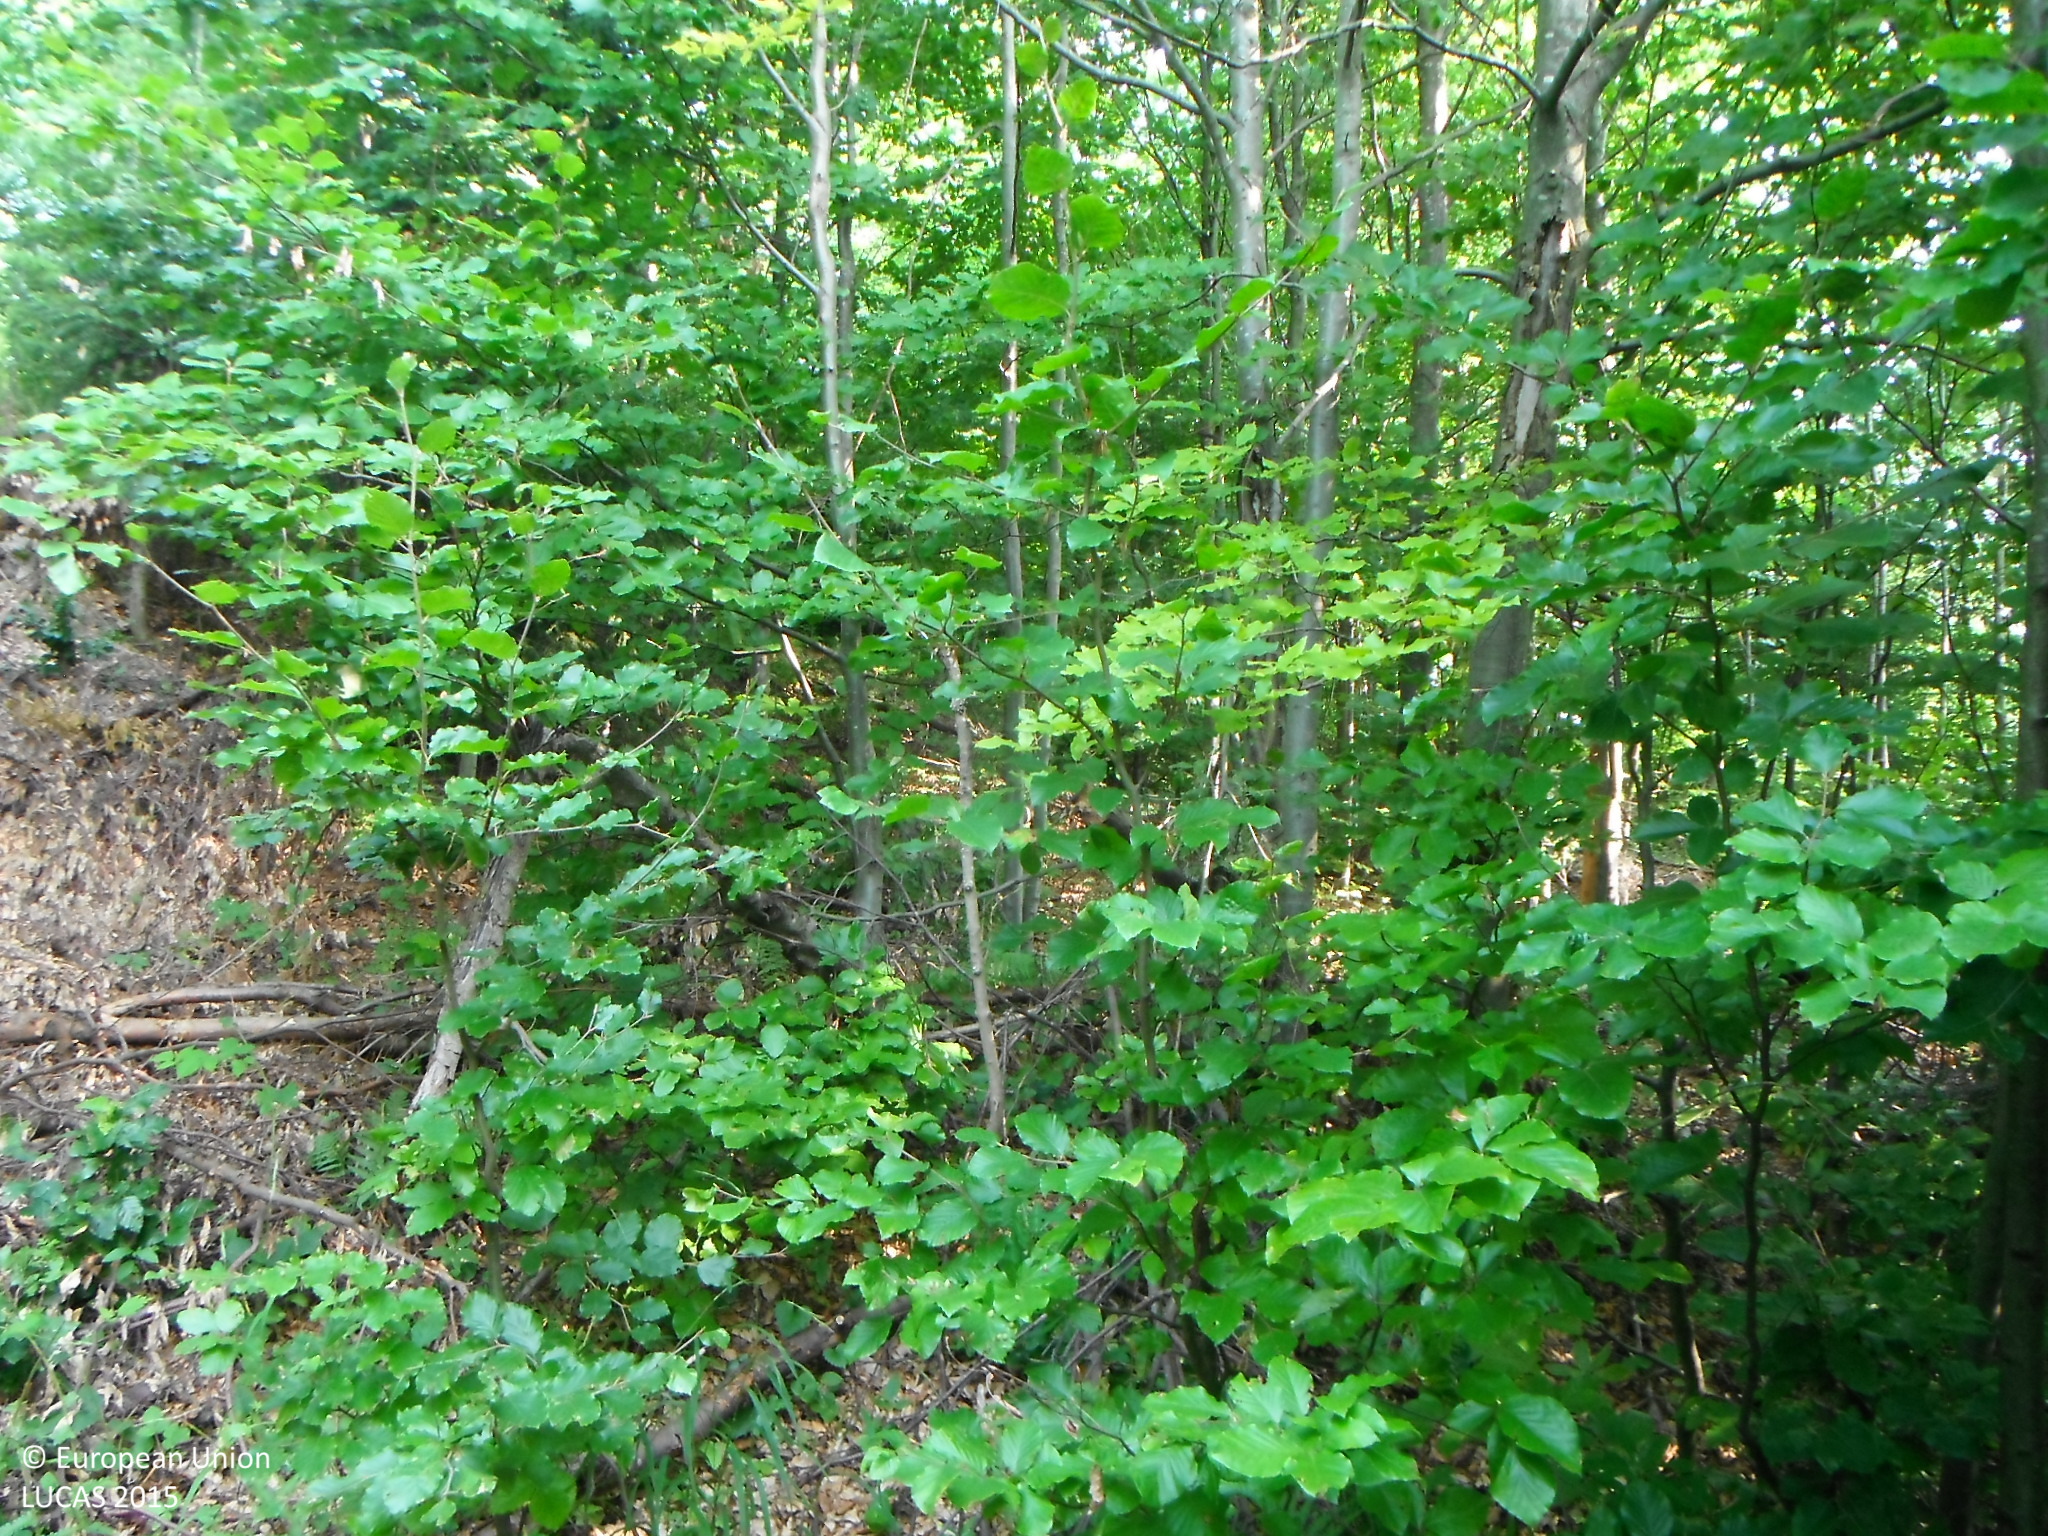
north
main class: Woodland
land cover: Broadleaved woodland
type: mountainous beech forest
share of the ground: > 75 %
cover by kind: broadleaved forest trees 100 %
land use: Forestry
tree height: > 5 m
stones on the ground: < 10 %
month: August
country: SK
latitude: 48.8481
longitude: 19.0293
